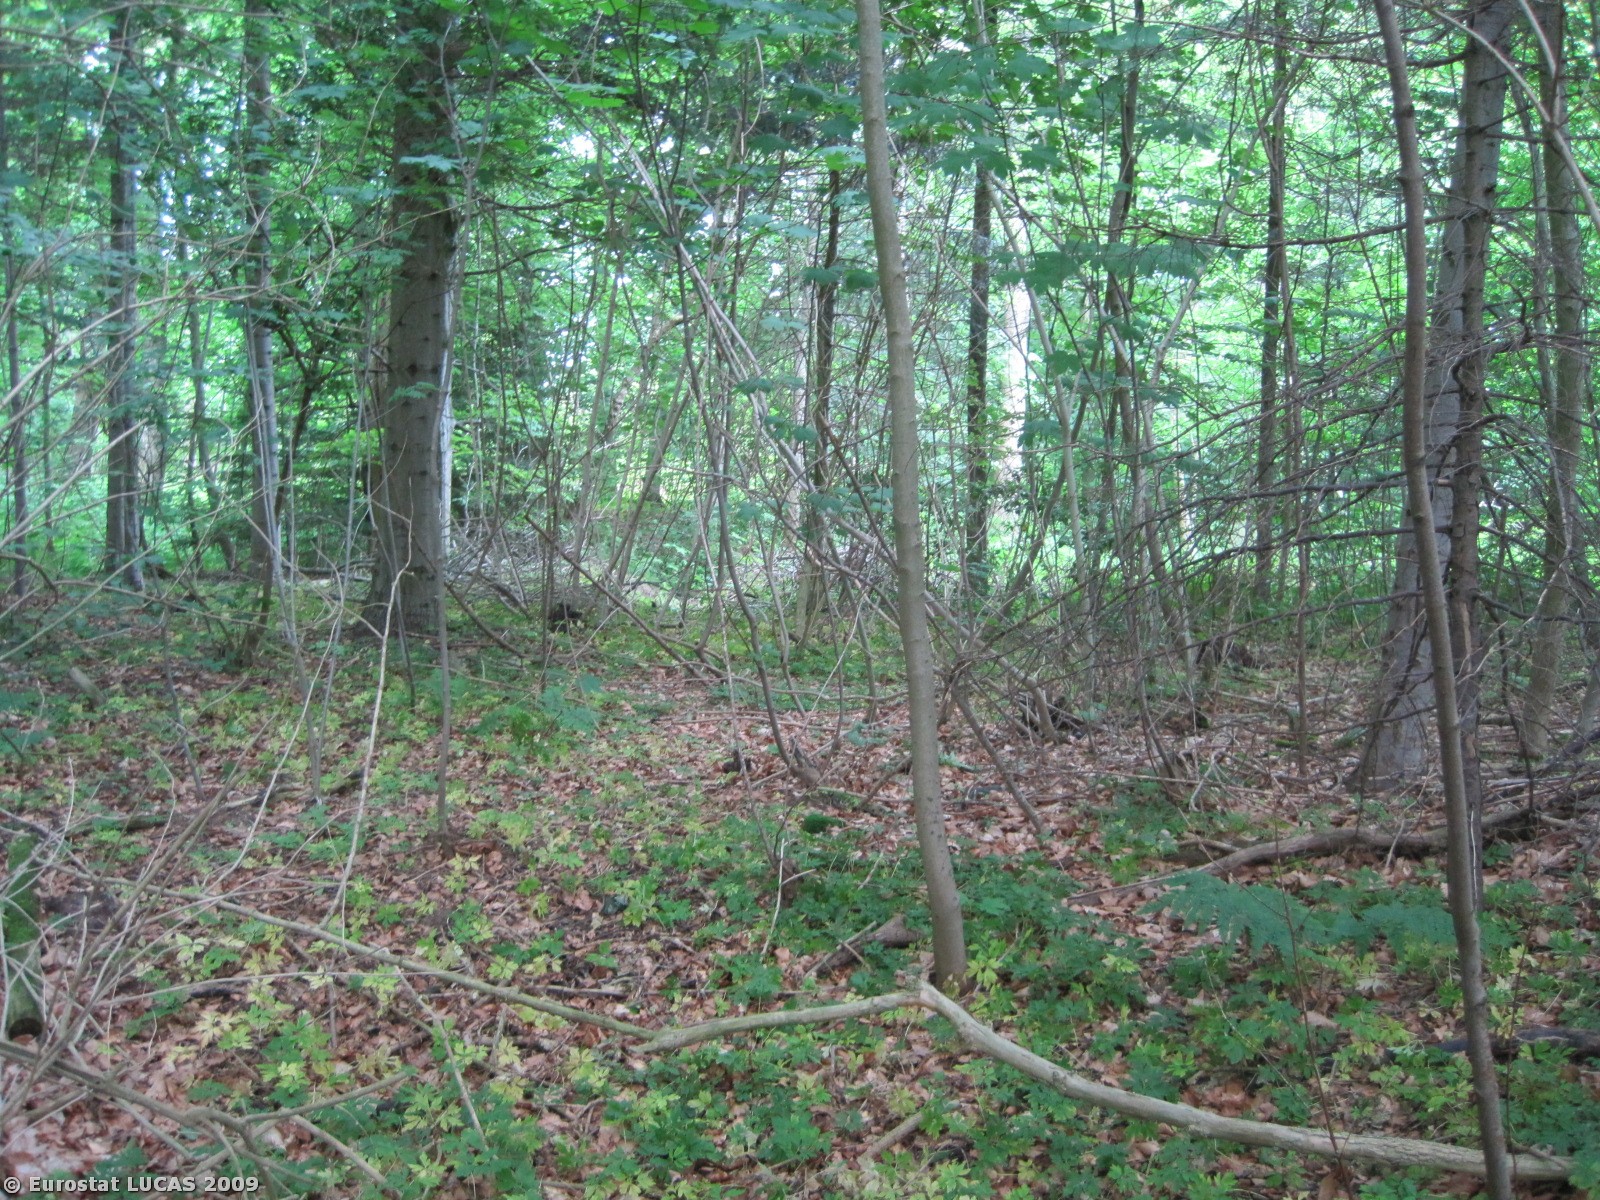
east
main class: Woodland
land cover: Mixed woodland
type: plantations and self-sown exotic forest
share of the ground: > 75 %
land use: Amenities, museums, leisure
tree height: > 5 m
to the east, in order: Mixed woodland; Grass margins; Tracks; Paved roads, cycling and walking lanes; Shrubland with sparse tree cover; Grassland with sparse tree/shrub cover; Artificial constructions in urban areas
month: June
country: DK
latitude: 57.1582
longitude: 10.2806
